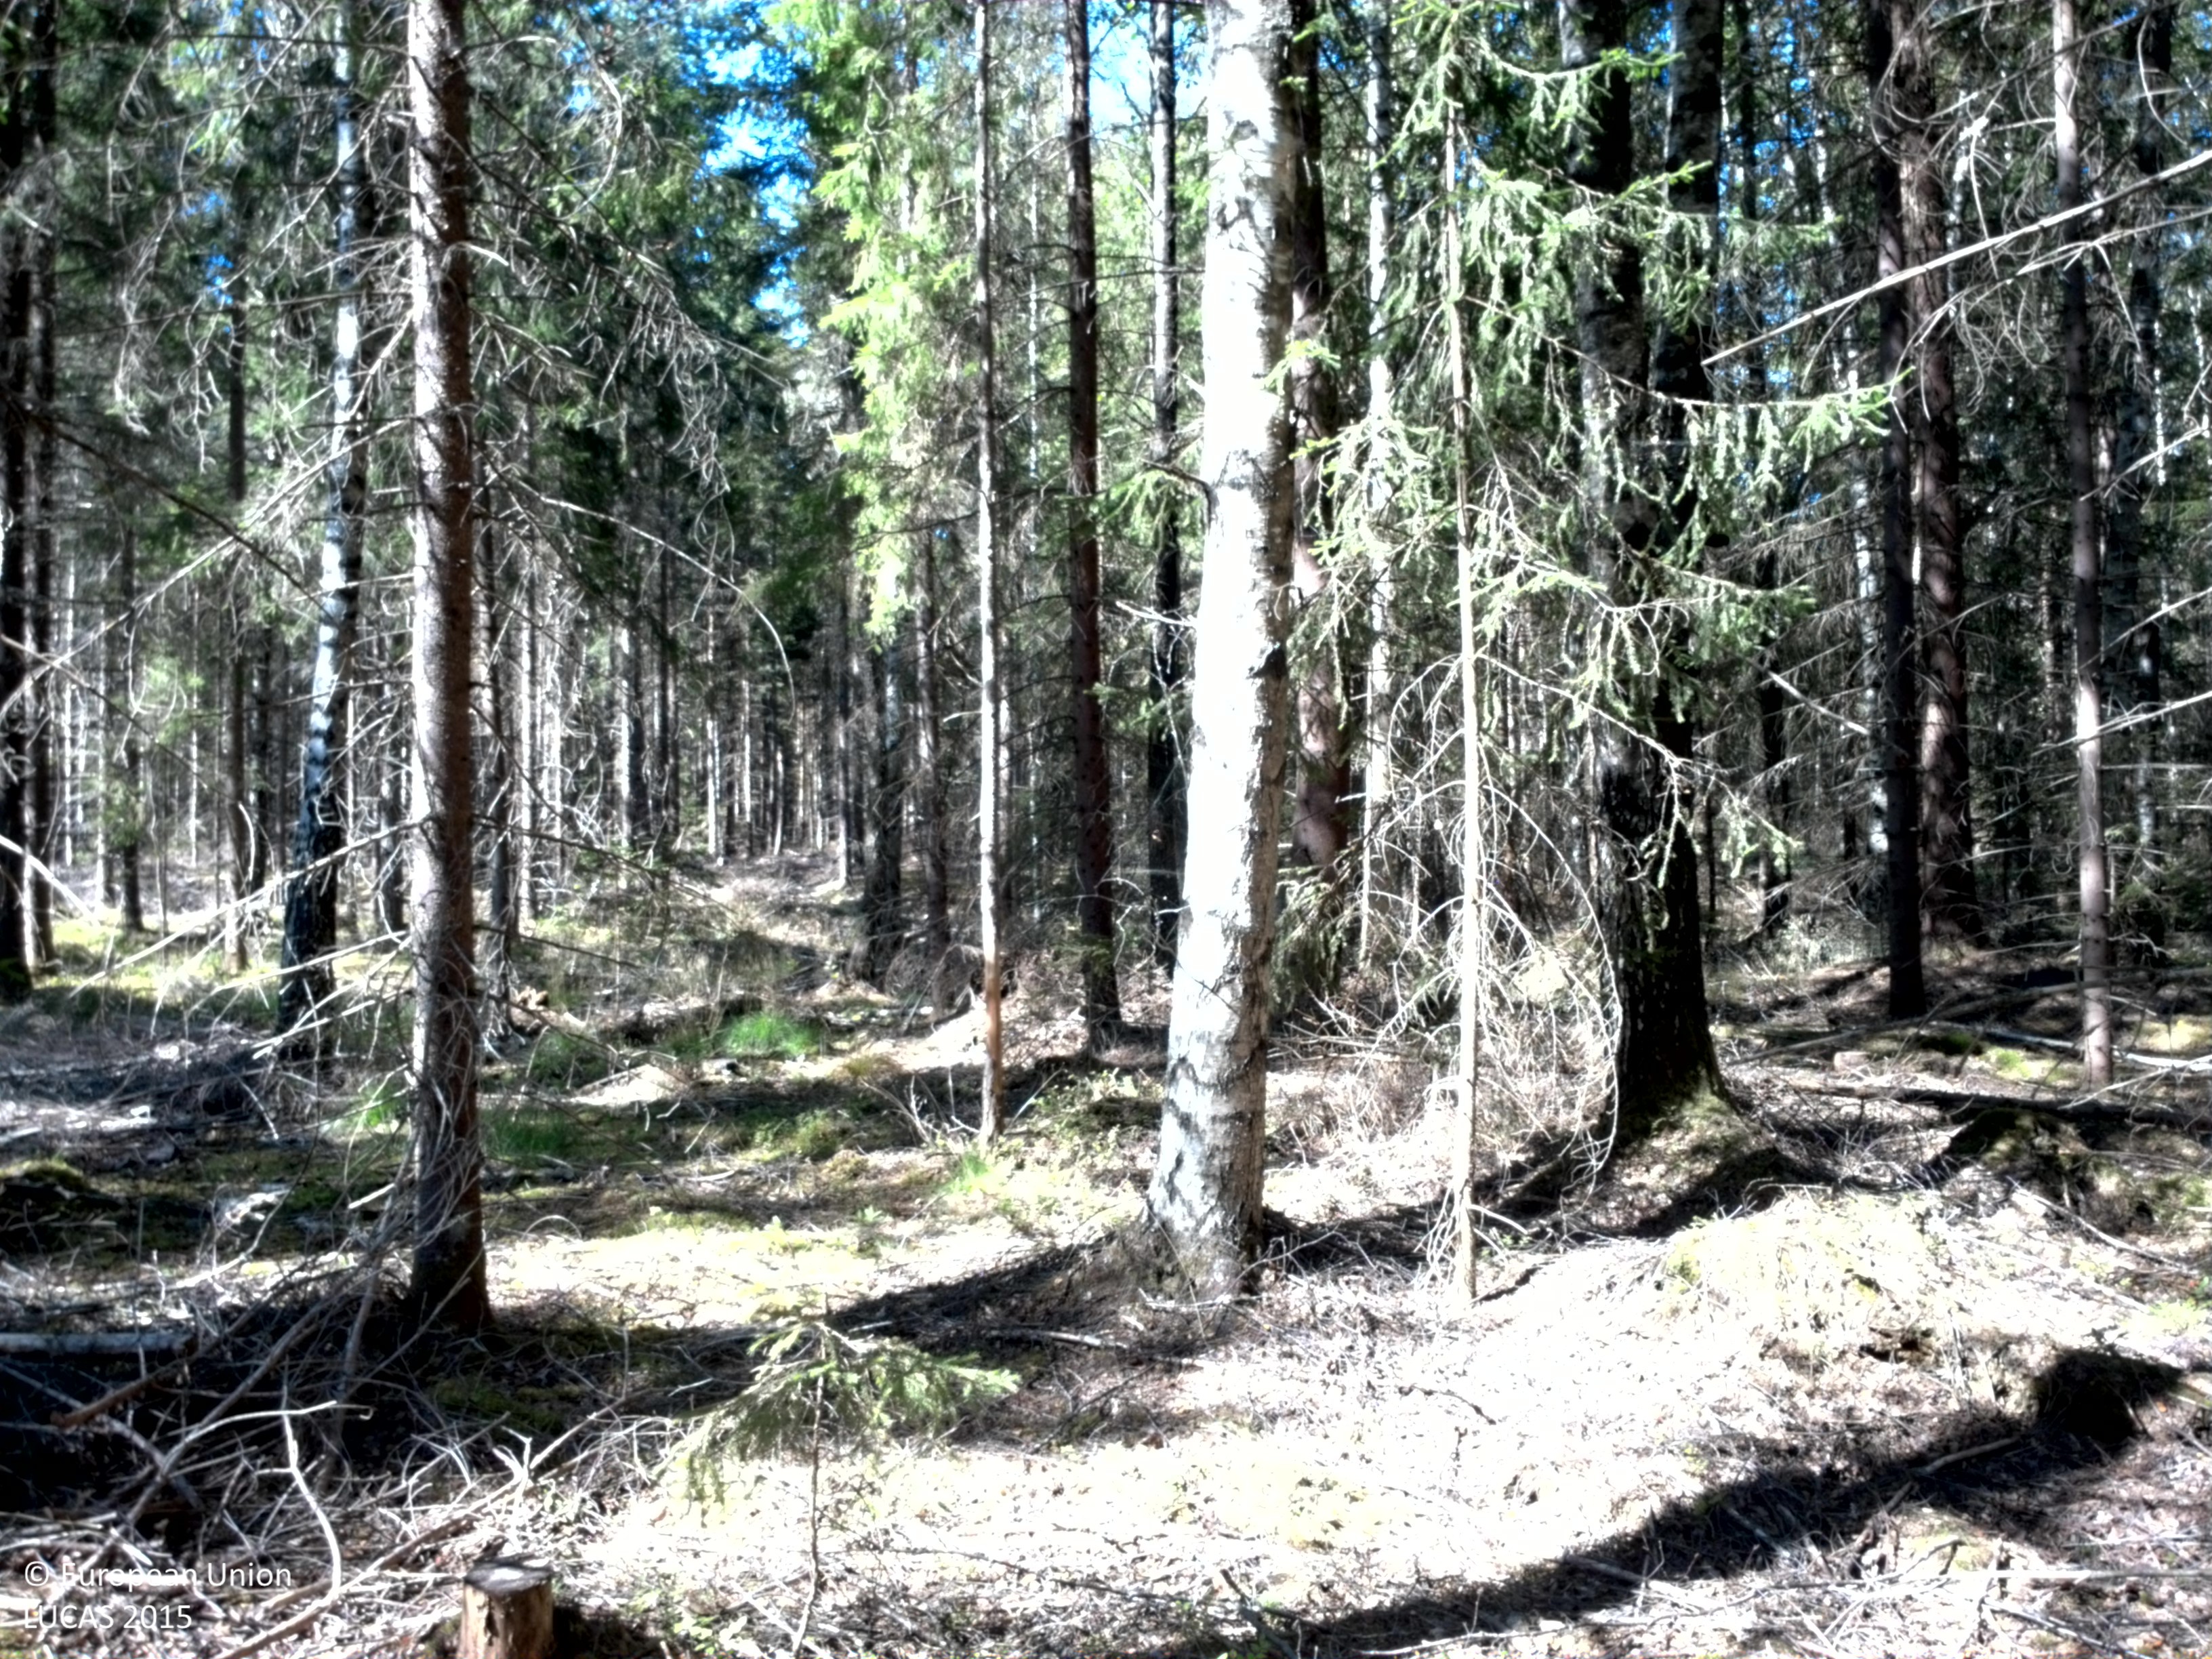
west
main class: Woodland
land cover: Spruce dominated coniferous woodland
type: boreal forest
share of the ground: 50 - 75 %
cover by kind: coniferous forest trees 65 %, lichens and mosses 25 %, broadleaved forest trees 5 %, shrubs 5 %
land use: Forestry
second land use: Amenities, museums, leisure
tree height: > 5 m
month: August
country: SE
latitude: 59.4381
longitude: 13.3599
